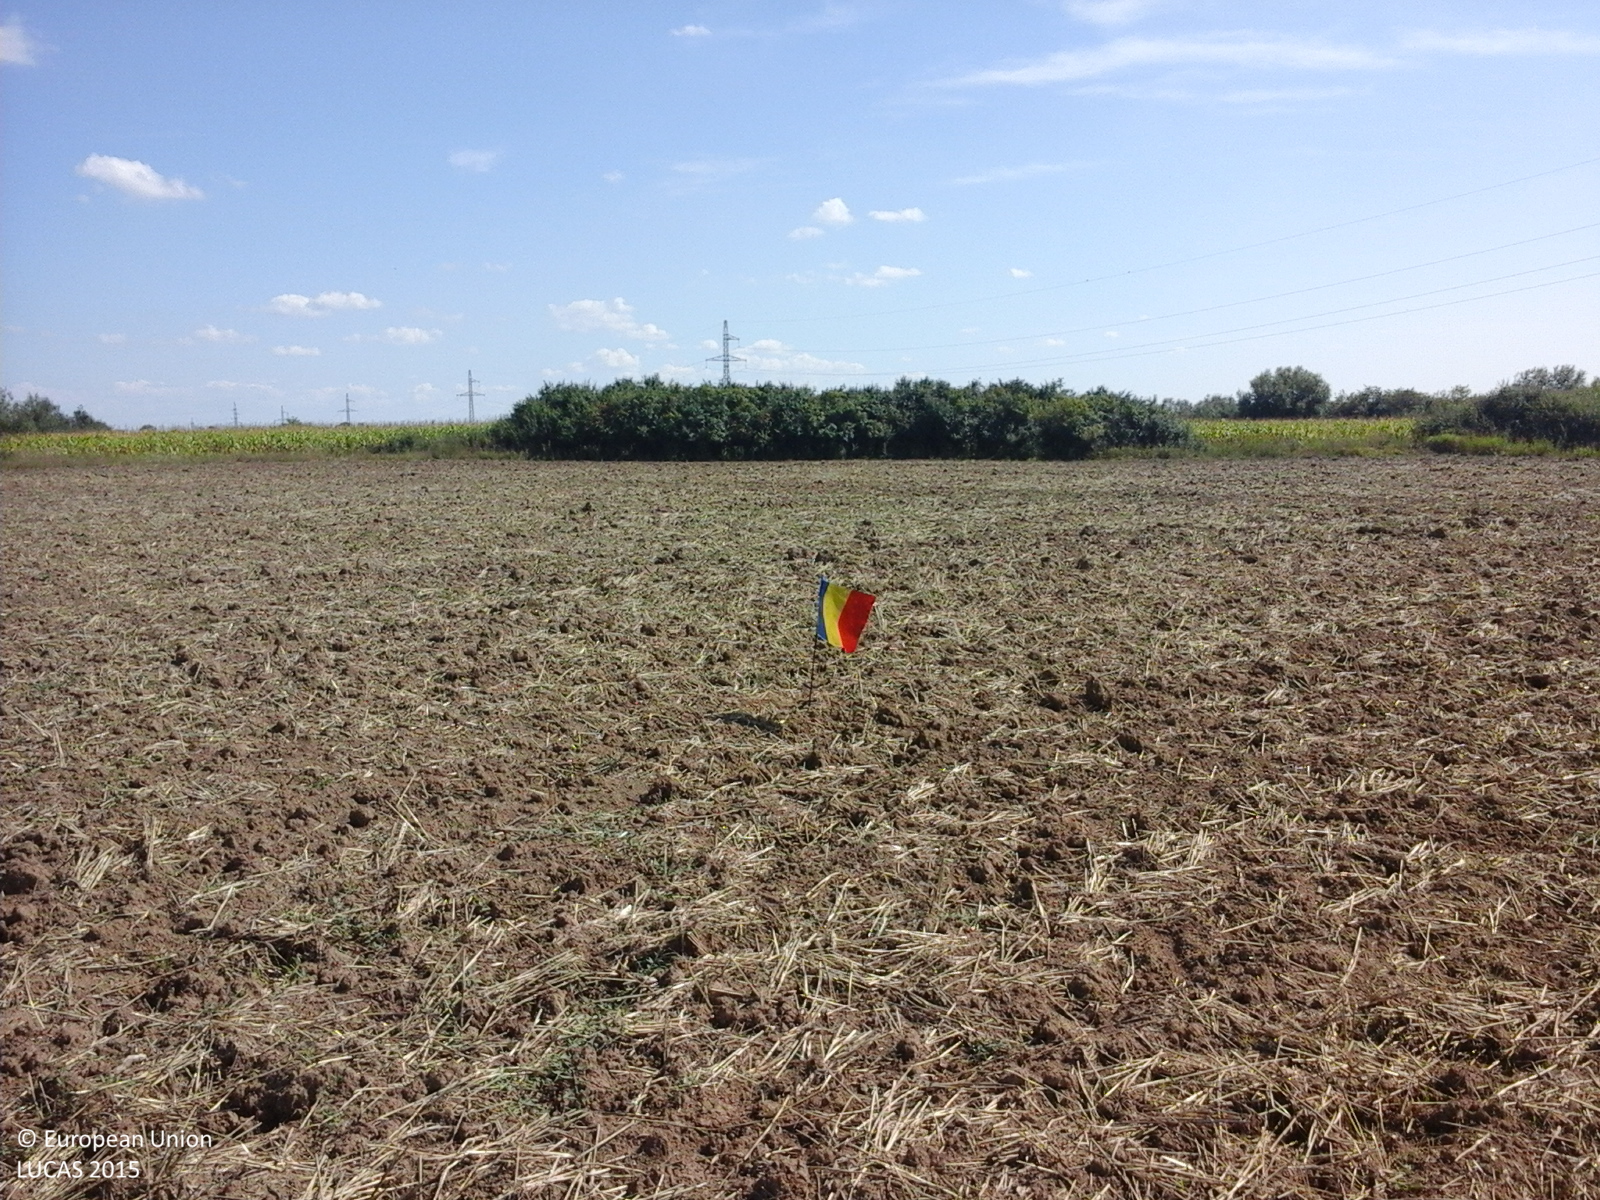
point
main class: Cropland
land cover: Common wheat
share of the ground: 25 - 50 %
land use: Agriculture (excluding fallow land and kitchen gardens)
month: August
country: RO
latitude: 45.7332
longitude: 21.1195
